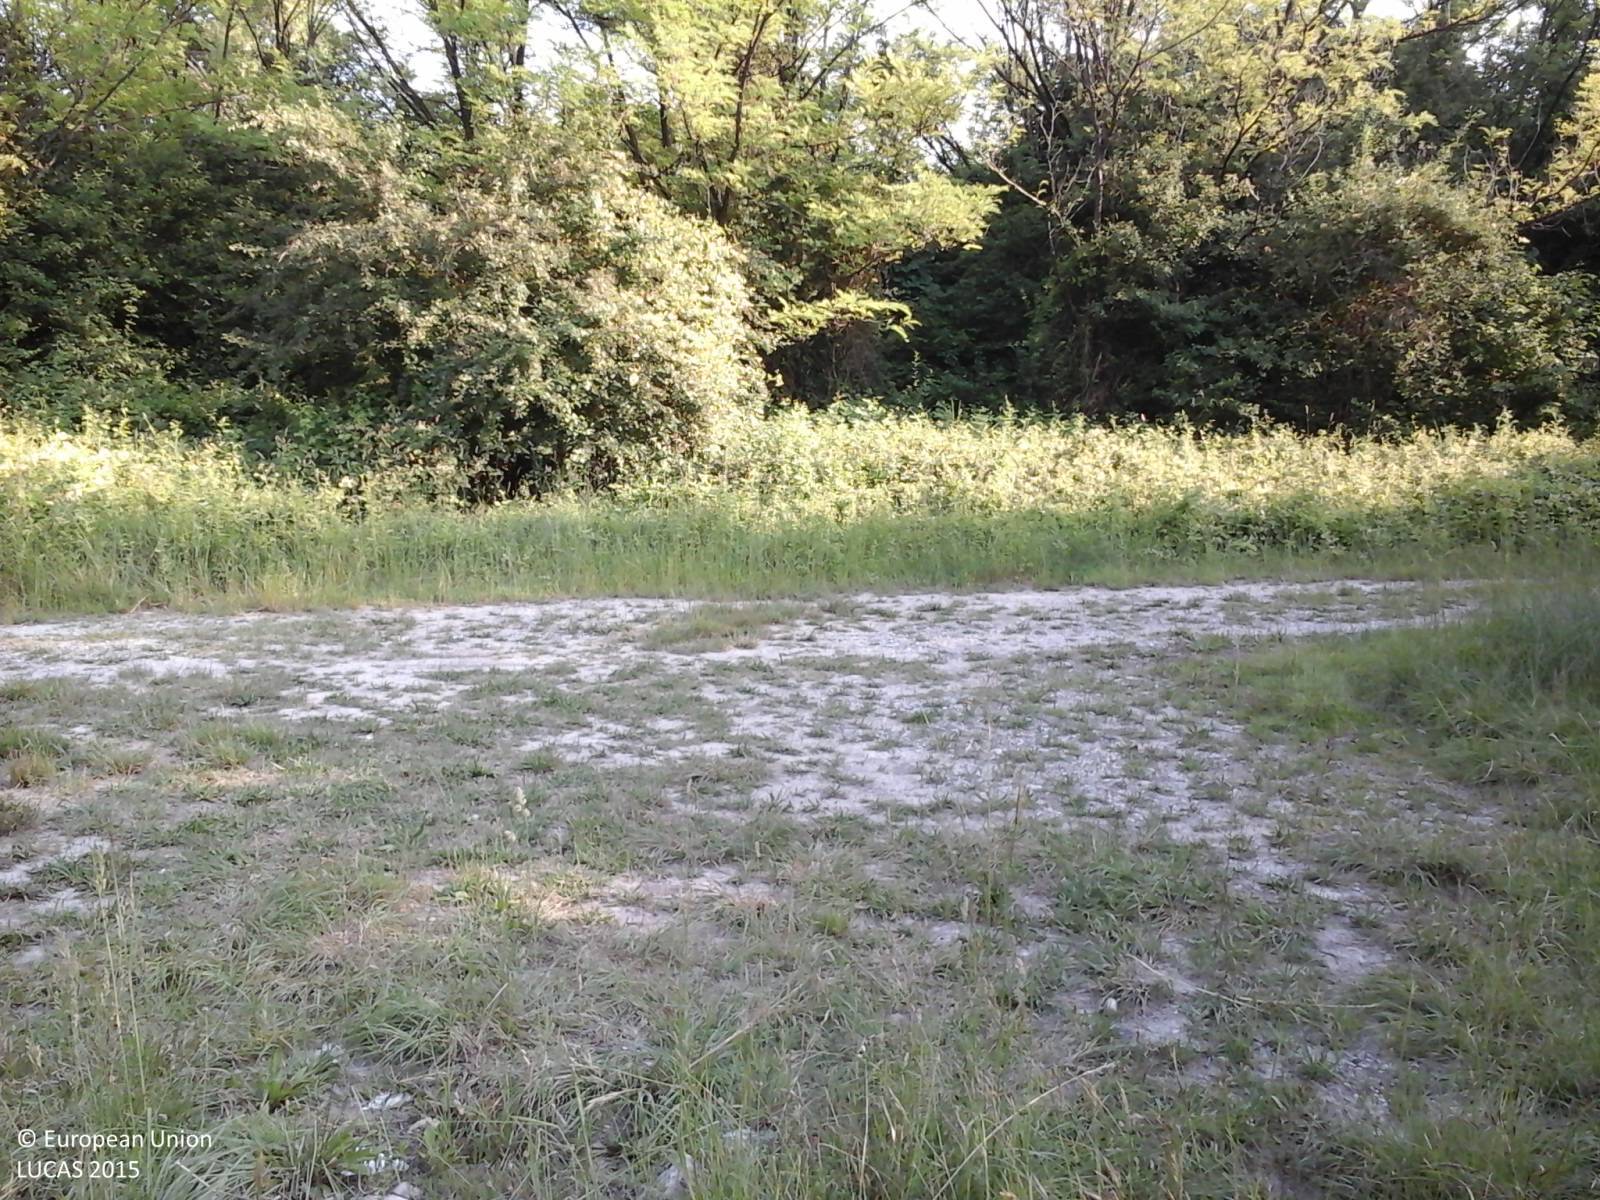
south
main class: Grassland
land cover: Grassland with sparse tree/shrub cover
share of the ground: > 75 %
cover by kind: herbaceous plants 95 %, broadleaved forest trees 5 %
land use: Semi-natural and natural areas not in use
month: May
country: IT
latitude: 45.8094
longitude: 13.4318
